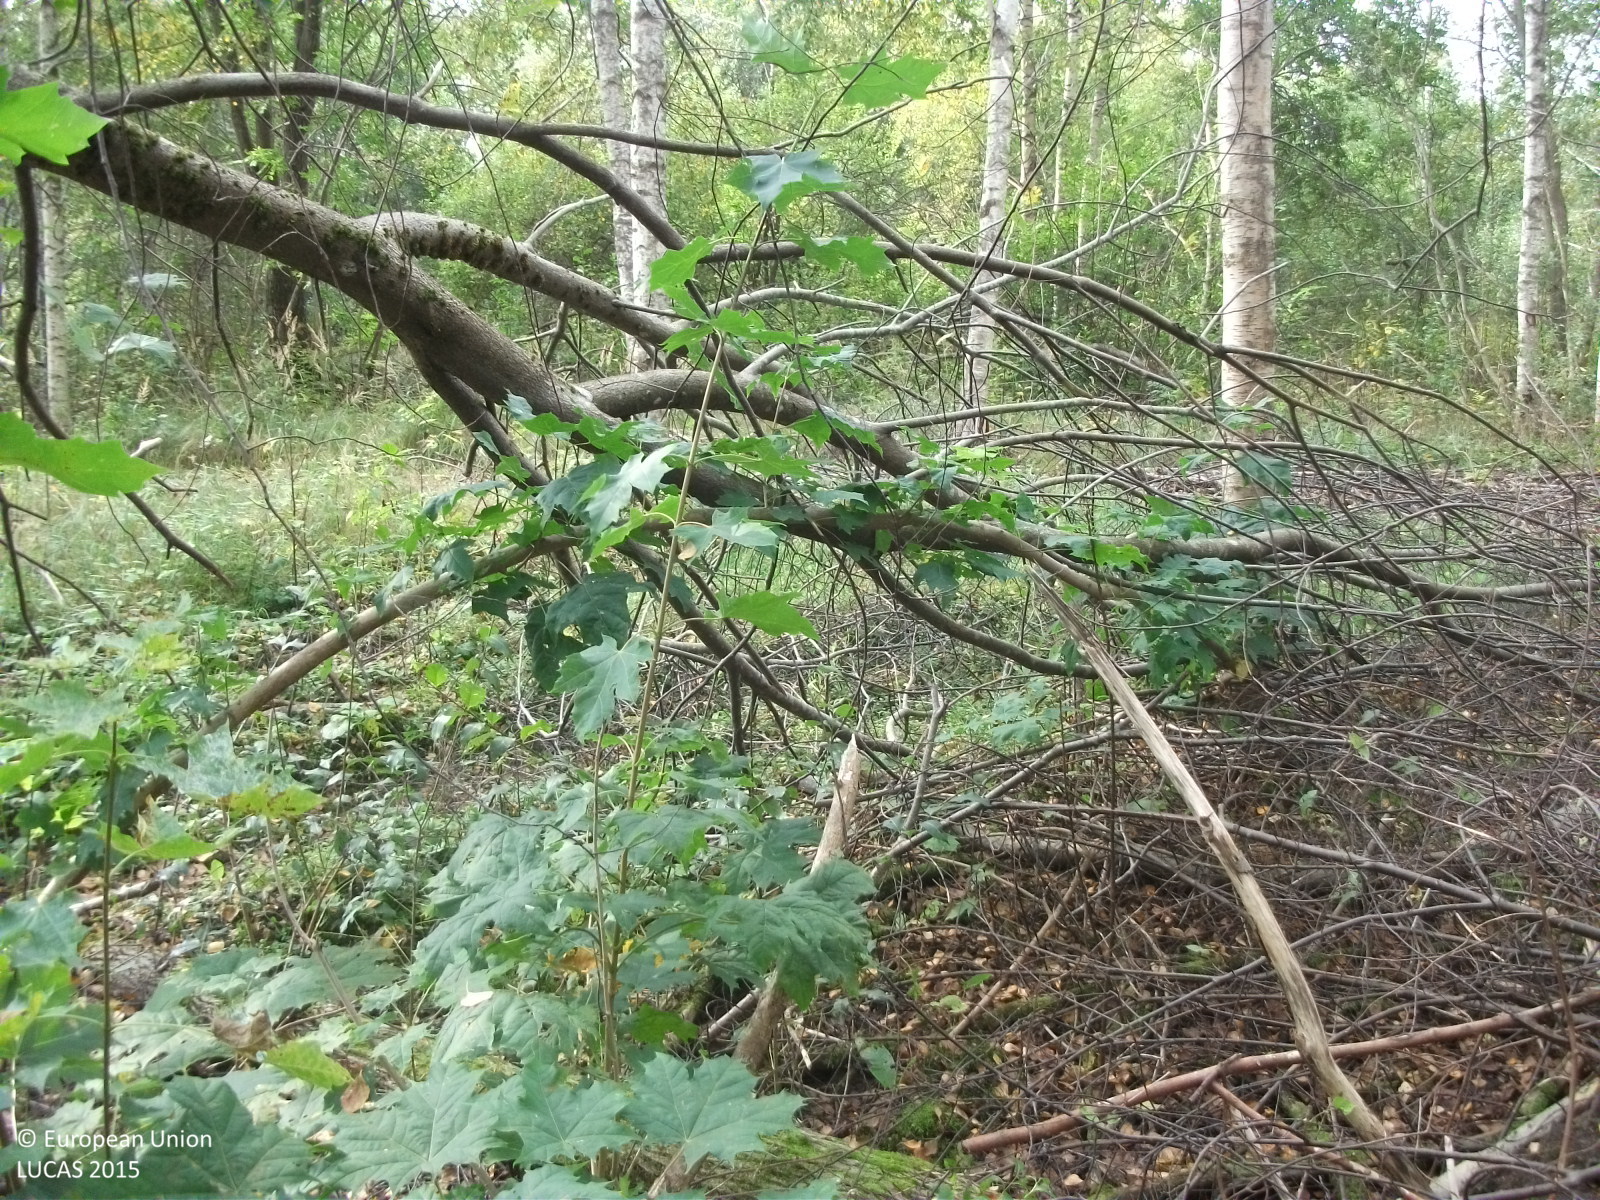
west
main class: Woodland
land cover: Broadleaved woodland
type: non-riverine alder, birch or aspen forest
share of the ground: > 75 %
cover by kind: broadleaved forest trees 80 %, herbaceous plants 10 %, shrubs 5 %
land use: Forestry
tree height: > 5 m
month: September
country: LV
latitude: 57.7965
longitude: 24.4732
